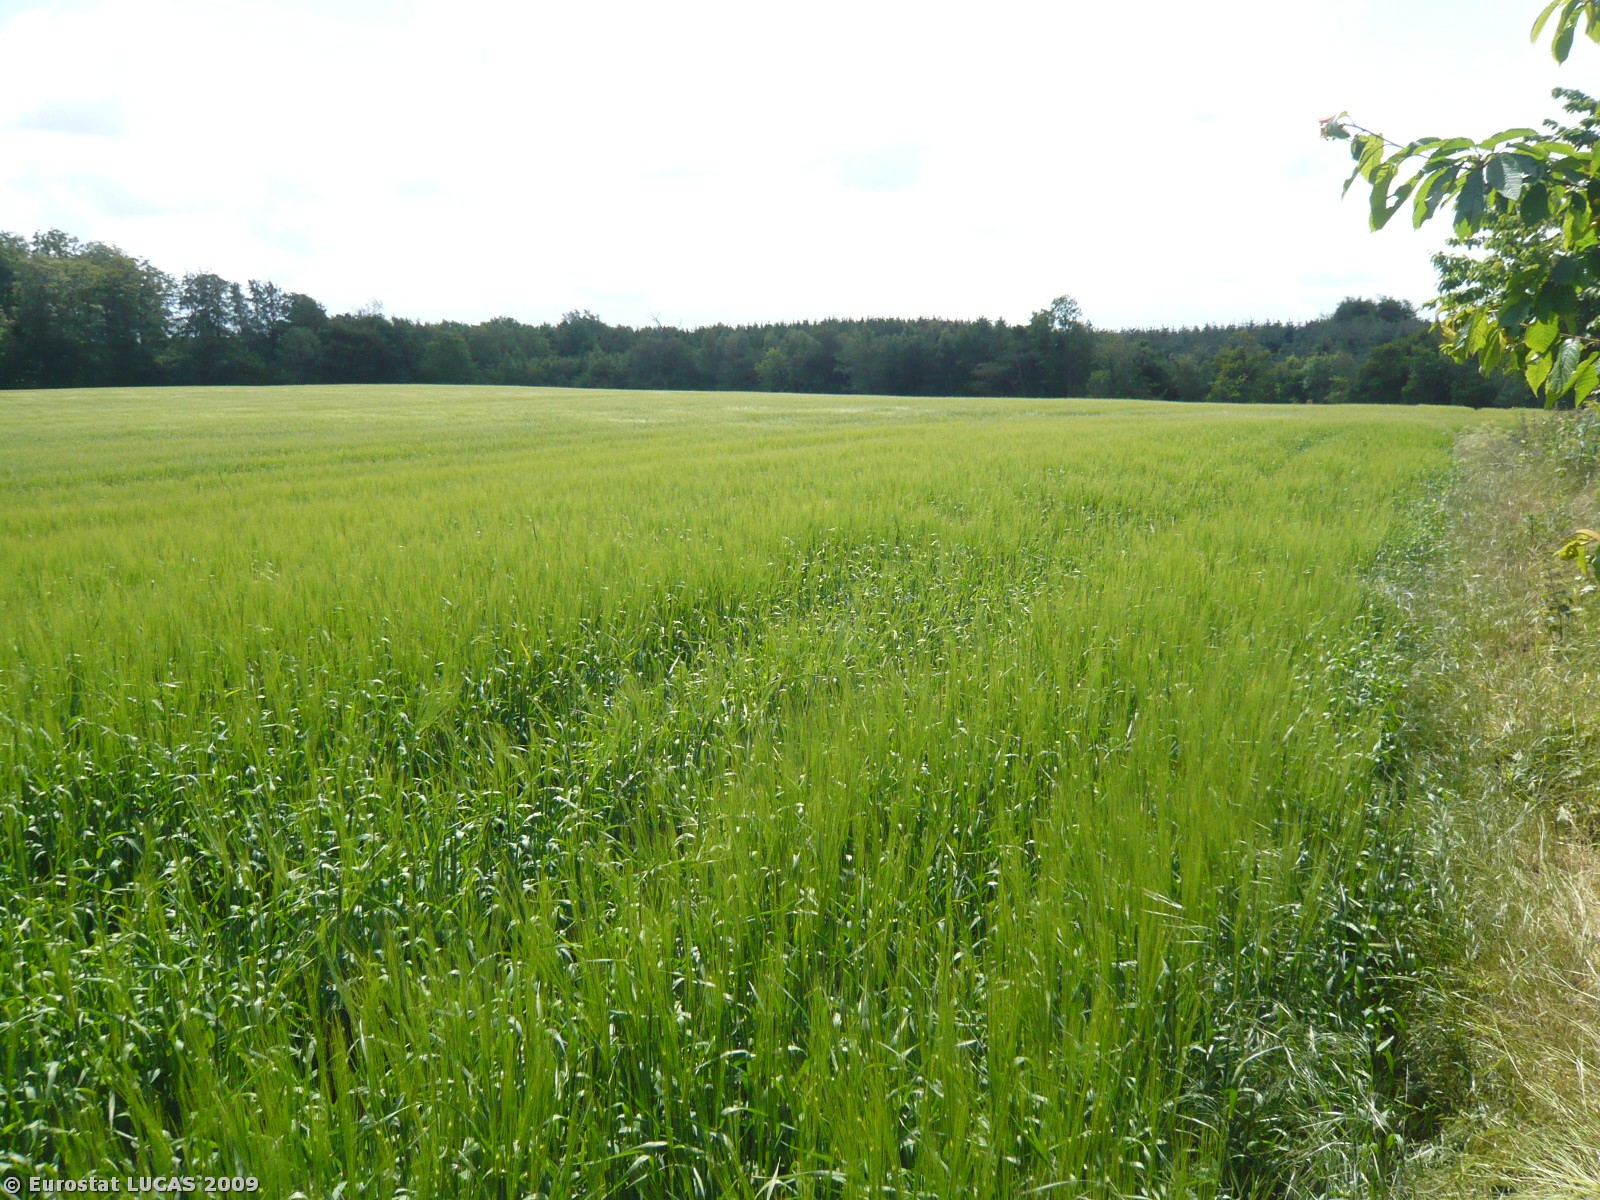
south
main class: Cropland
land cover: Barley
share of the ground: > 75 %
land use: Agriculture (excluding fallow land and kitchen gardens)
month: June
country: DK
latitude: 54.9408
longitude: 11.2947
